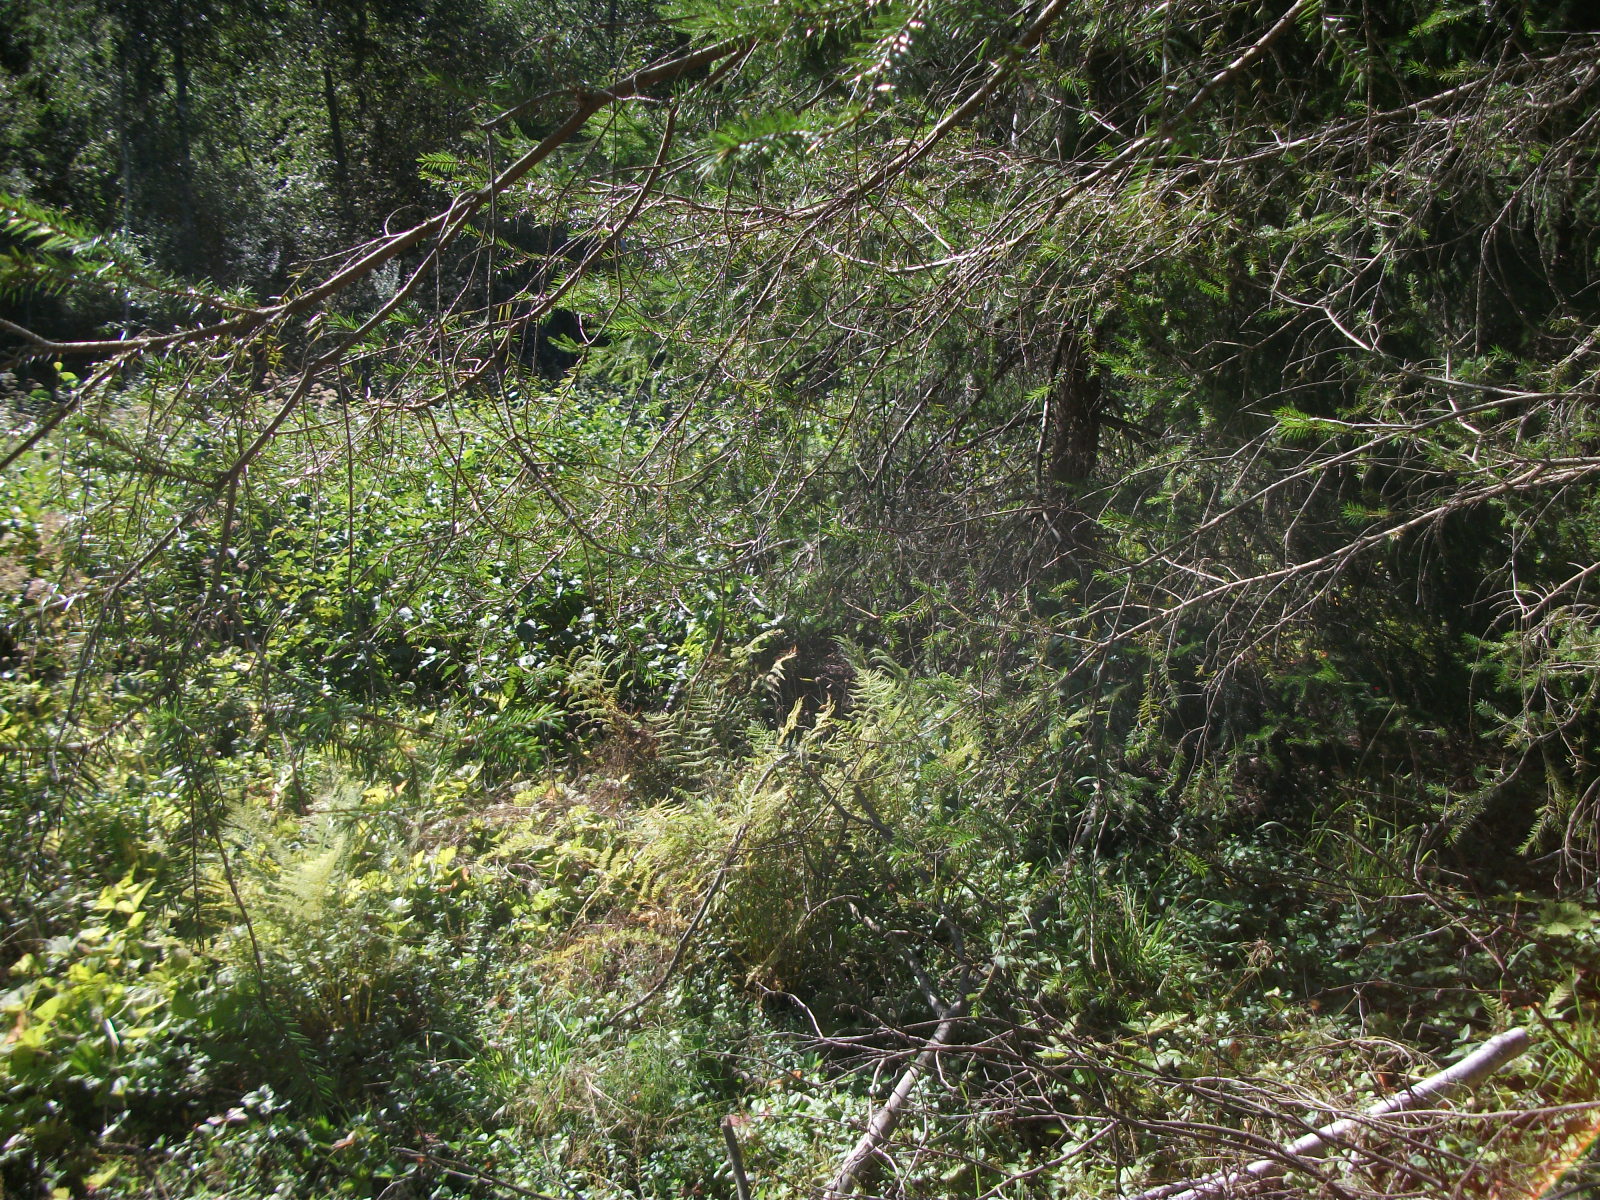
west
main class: Woodland
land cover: Spruce dominated mixed woodland
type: hemiboreal forest and nemoral coniferous forest and mixed broadleaved-coniferous forest
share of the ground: 25 - 50 %
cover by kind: shrubs 40 %, broadleaved forest trees 30 %, coniferous forest trees 20 %, herbaceous plants 10 %
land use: Forestry
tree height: > 5 m
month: August
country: LV
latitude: 56.6512
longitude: 26.2378
